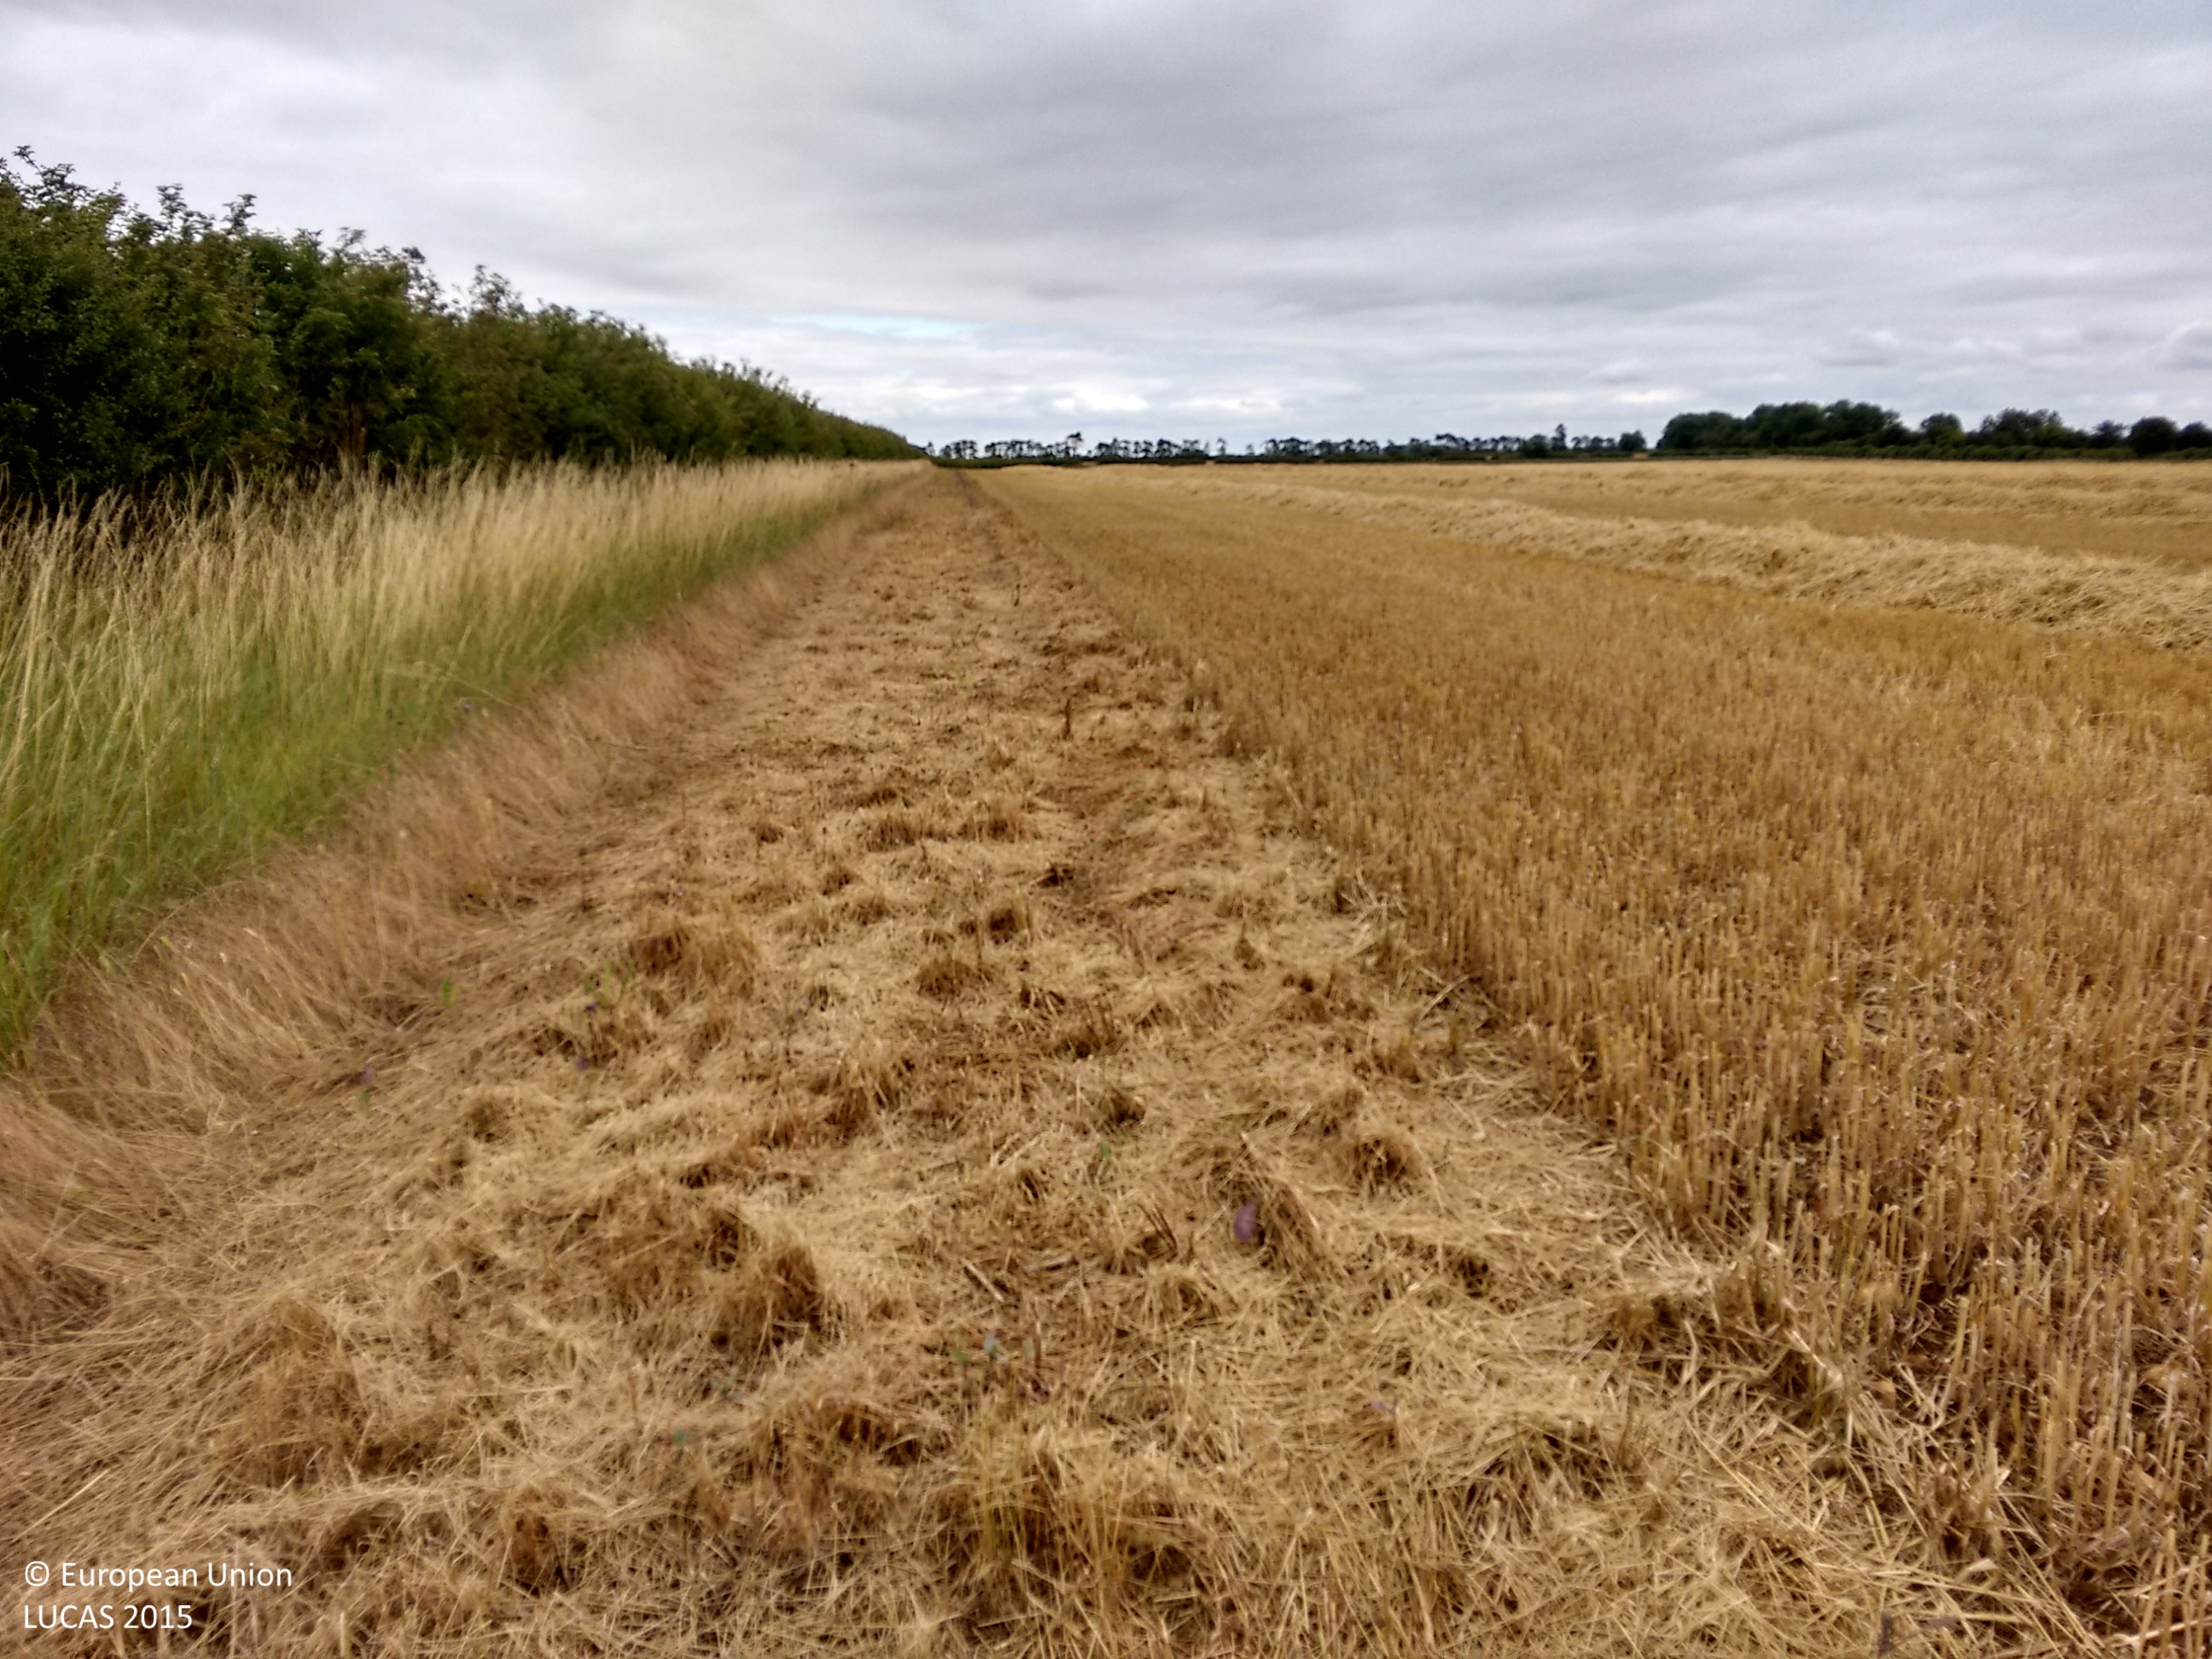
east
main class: Grassland
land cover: Grassland without tree/shrub cover
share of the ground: > 75 %
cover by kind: herbaceous plants 100 %
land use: Agriculture (excluding fallow land and kitchen gardens)
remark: Harvested field
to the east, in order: Grassland without tree/shrub cover; Common wheat
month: July
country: GB
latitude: 52.8496
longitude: -0.7469
